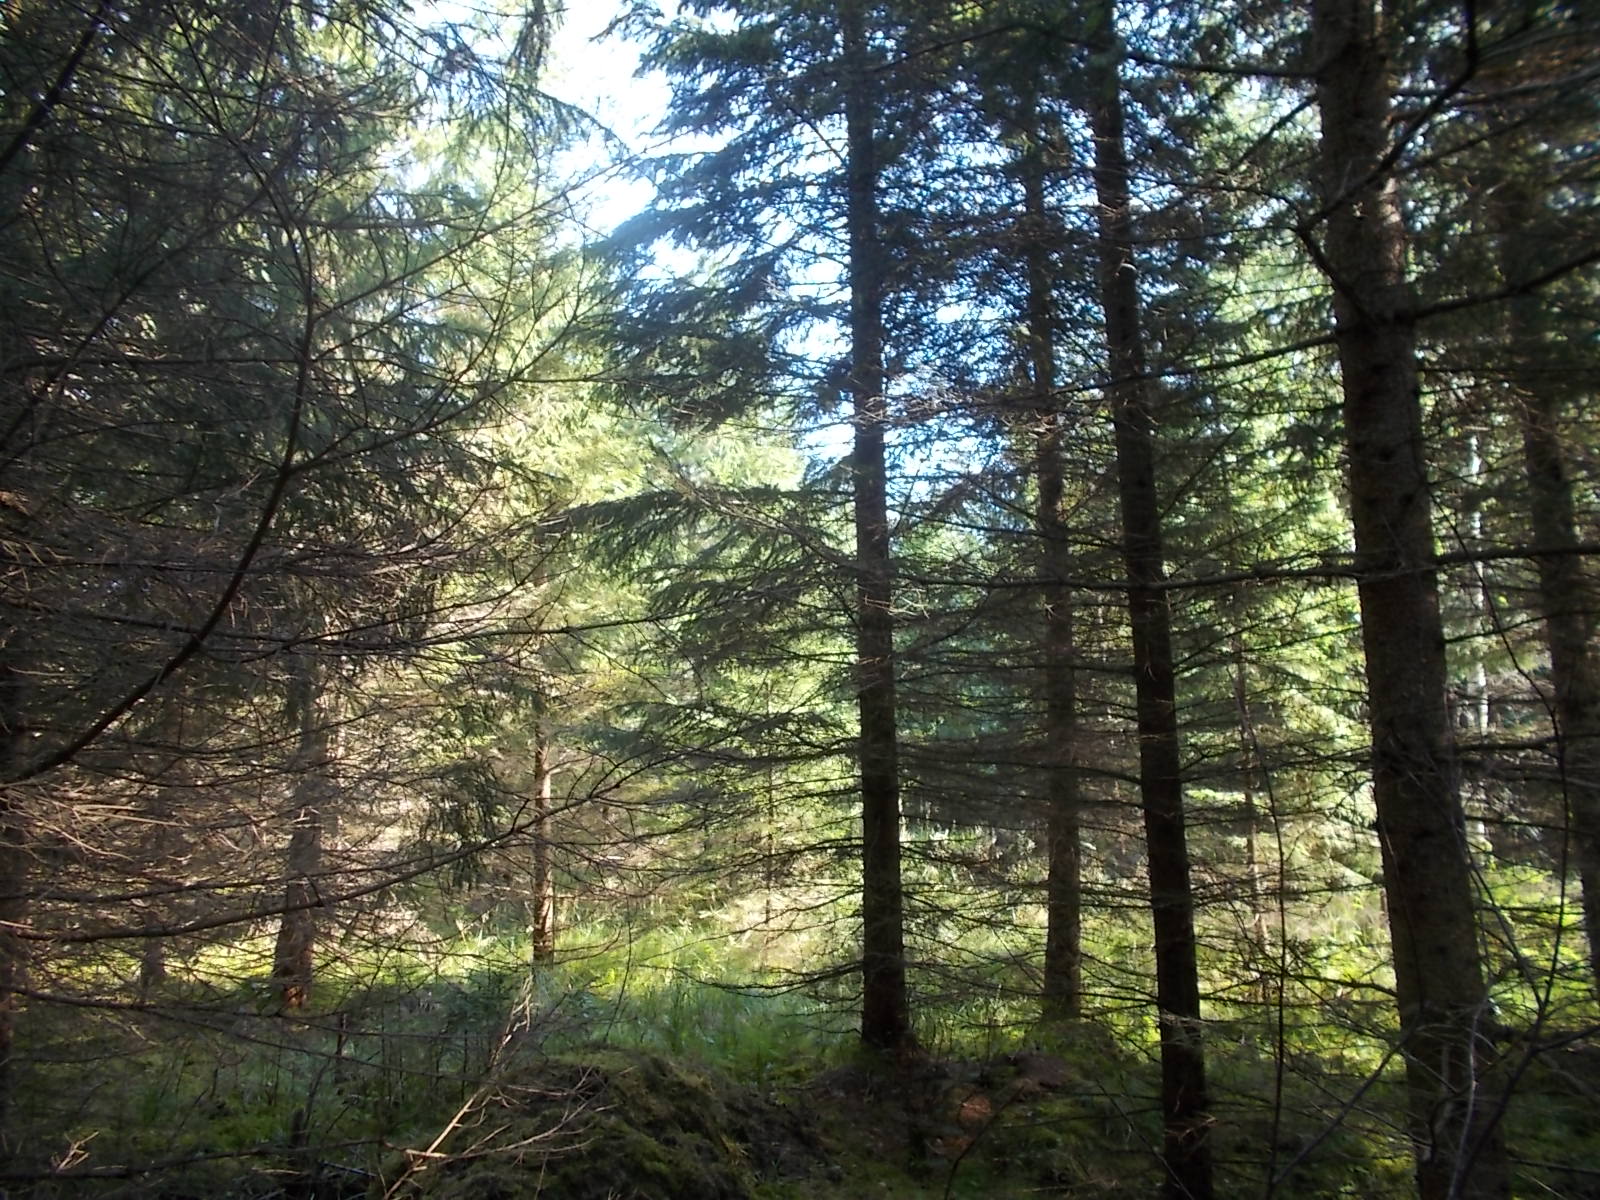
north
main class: Woodland
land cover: Spruce dominated coniferous woodland
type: hemiboreal forest and nemoral coniferous forest and mixed broadleaved-coniferous forest
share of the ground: 50 - 75 %
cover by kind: coniferous forest trees 70 %, shrubs 10 %, herbaceous plants 10 %, lichens and mosses 10 %
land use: Forestry
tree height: > 5 m
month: August
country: LV
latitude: 57.0541
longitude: 22.0668
